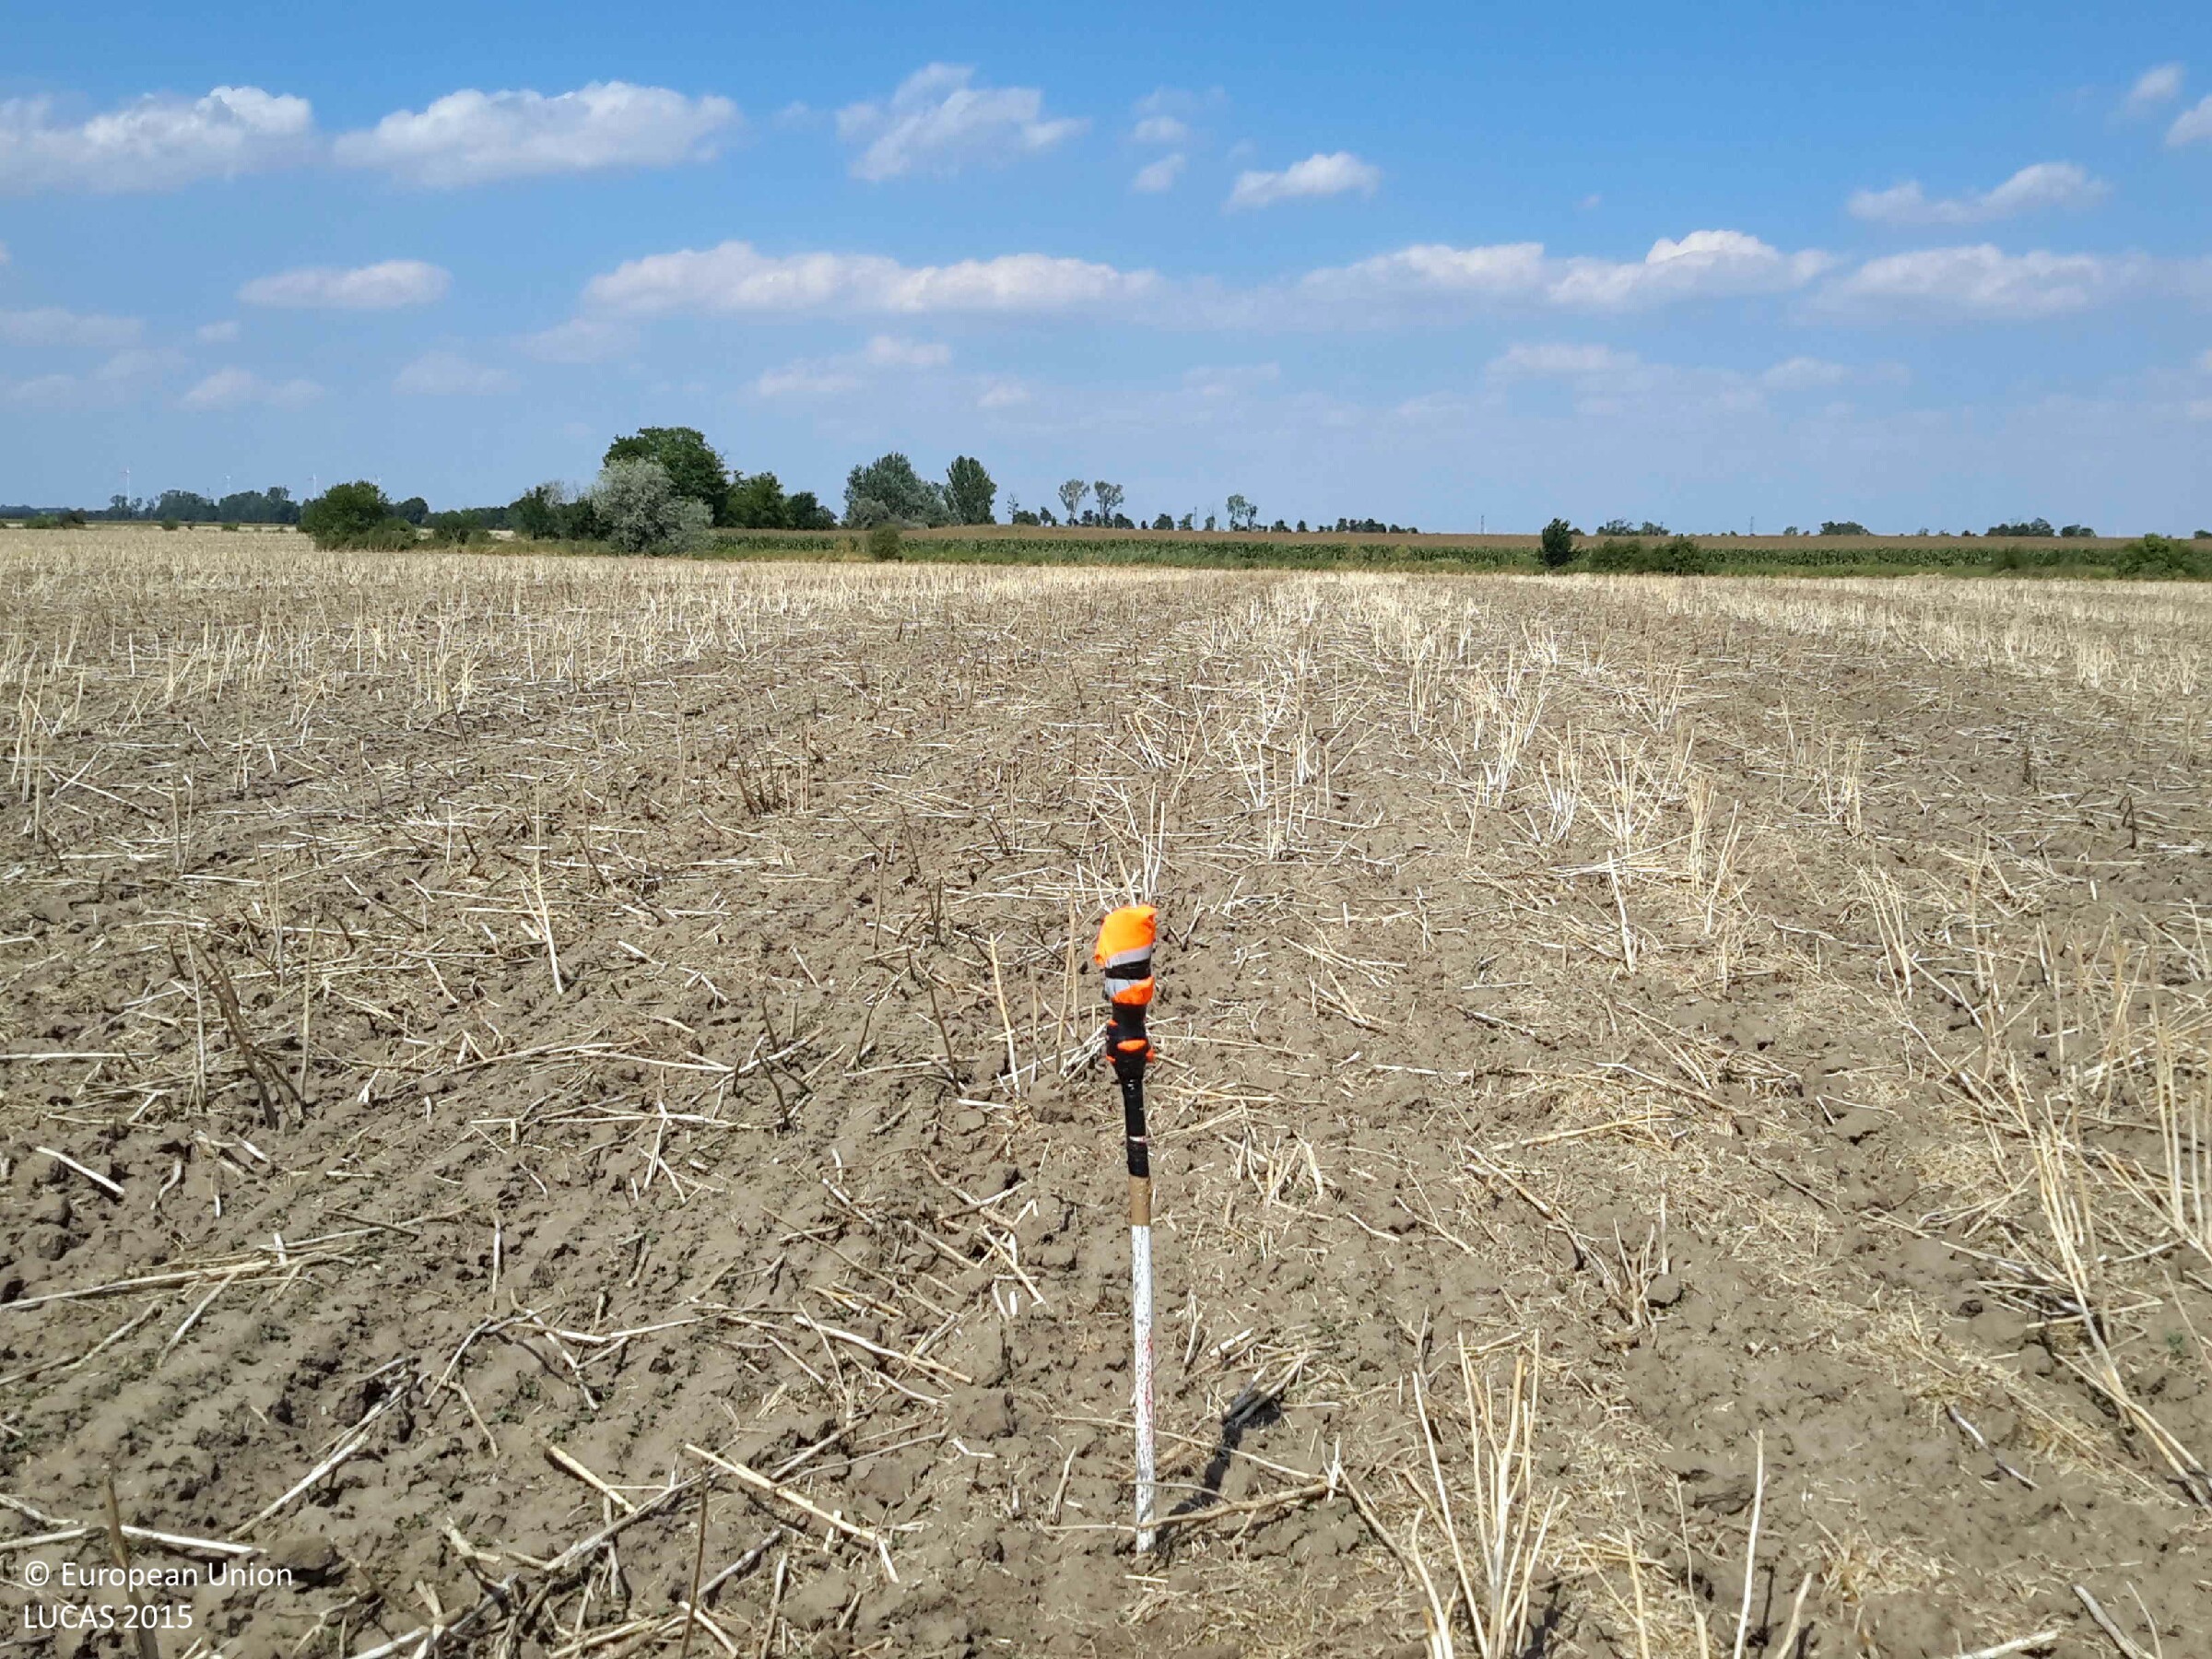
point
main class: Cropland
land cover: Rape and turnip rape
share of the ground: 50 - 75 %
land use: Agriculture (excluding fallow land and kitchen gardens)
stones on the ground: < 10 %
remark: Harvested field
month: July
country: HU
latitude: 47.6003
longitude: 17.8441
